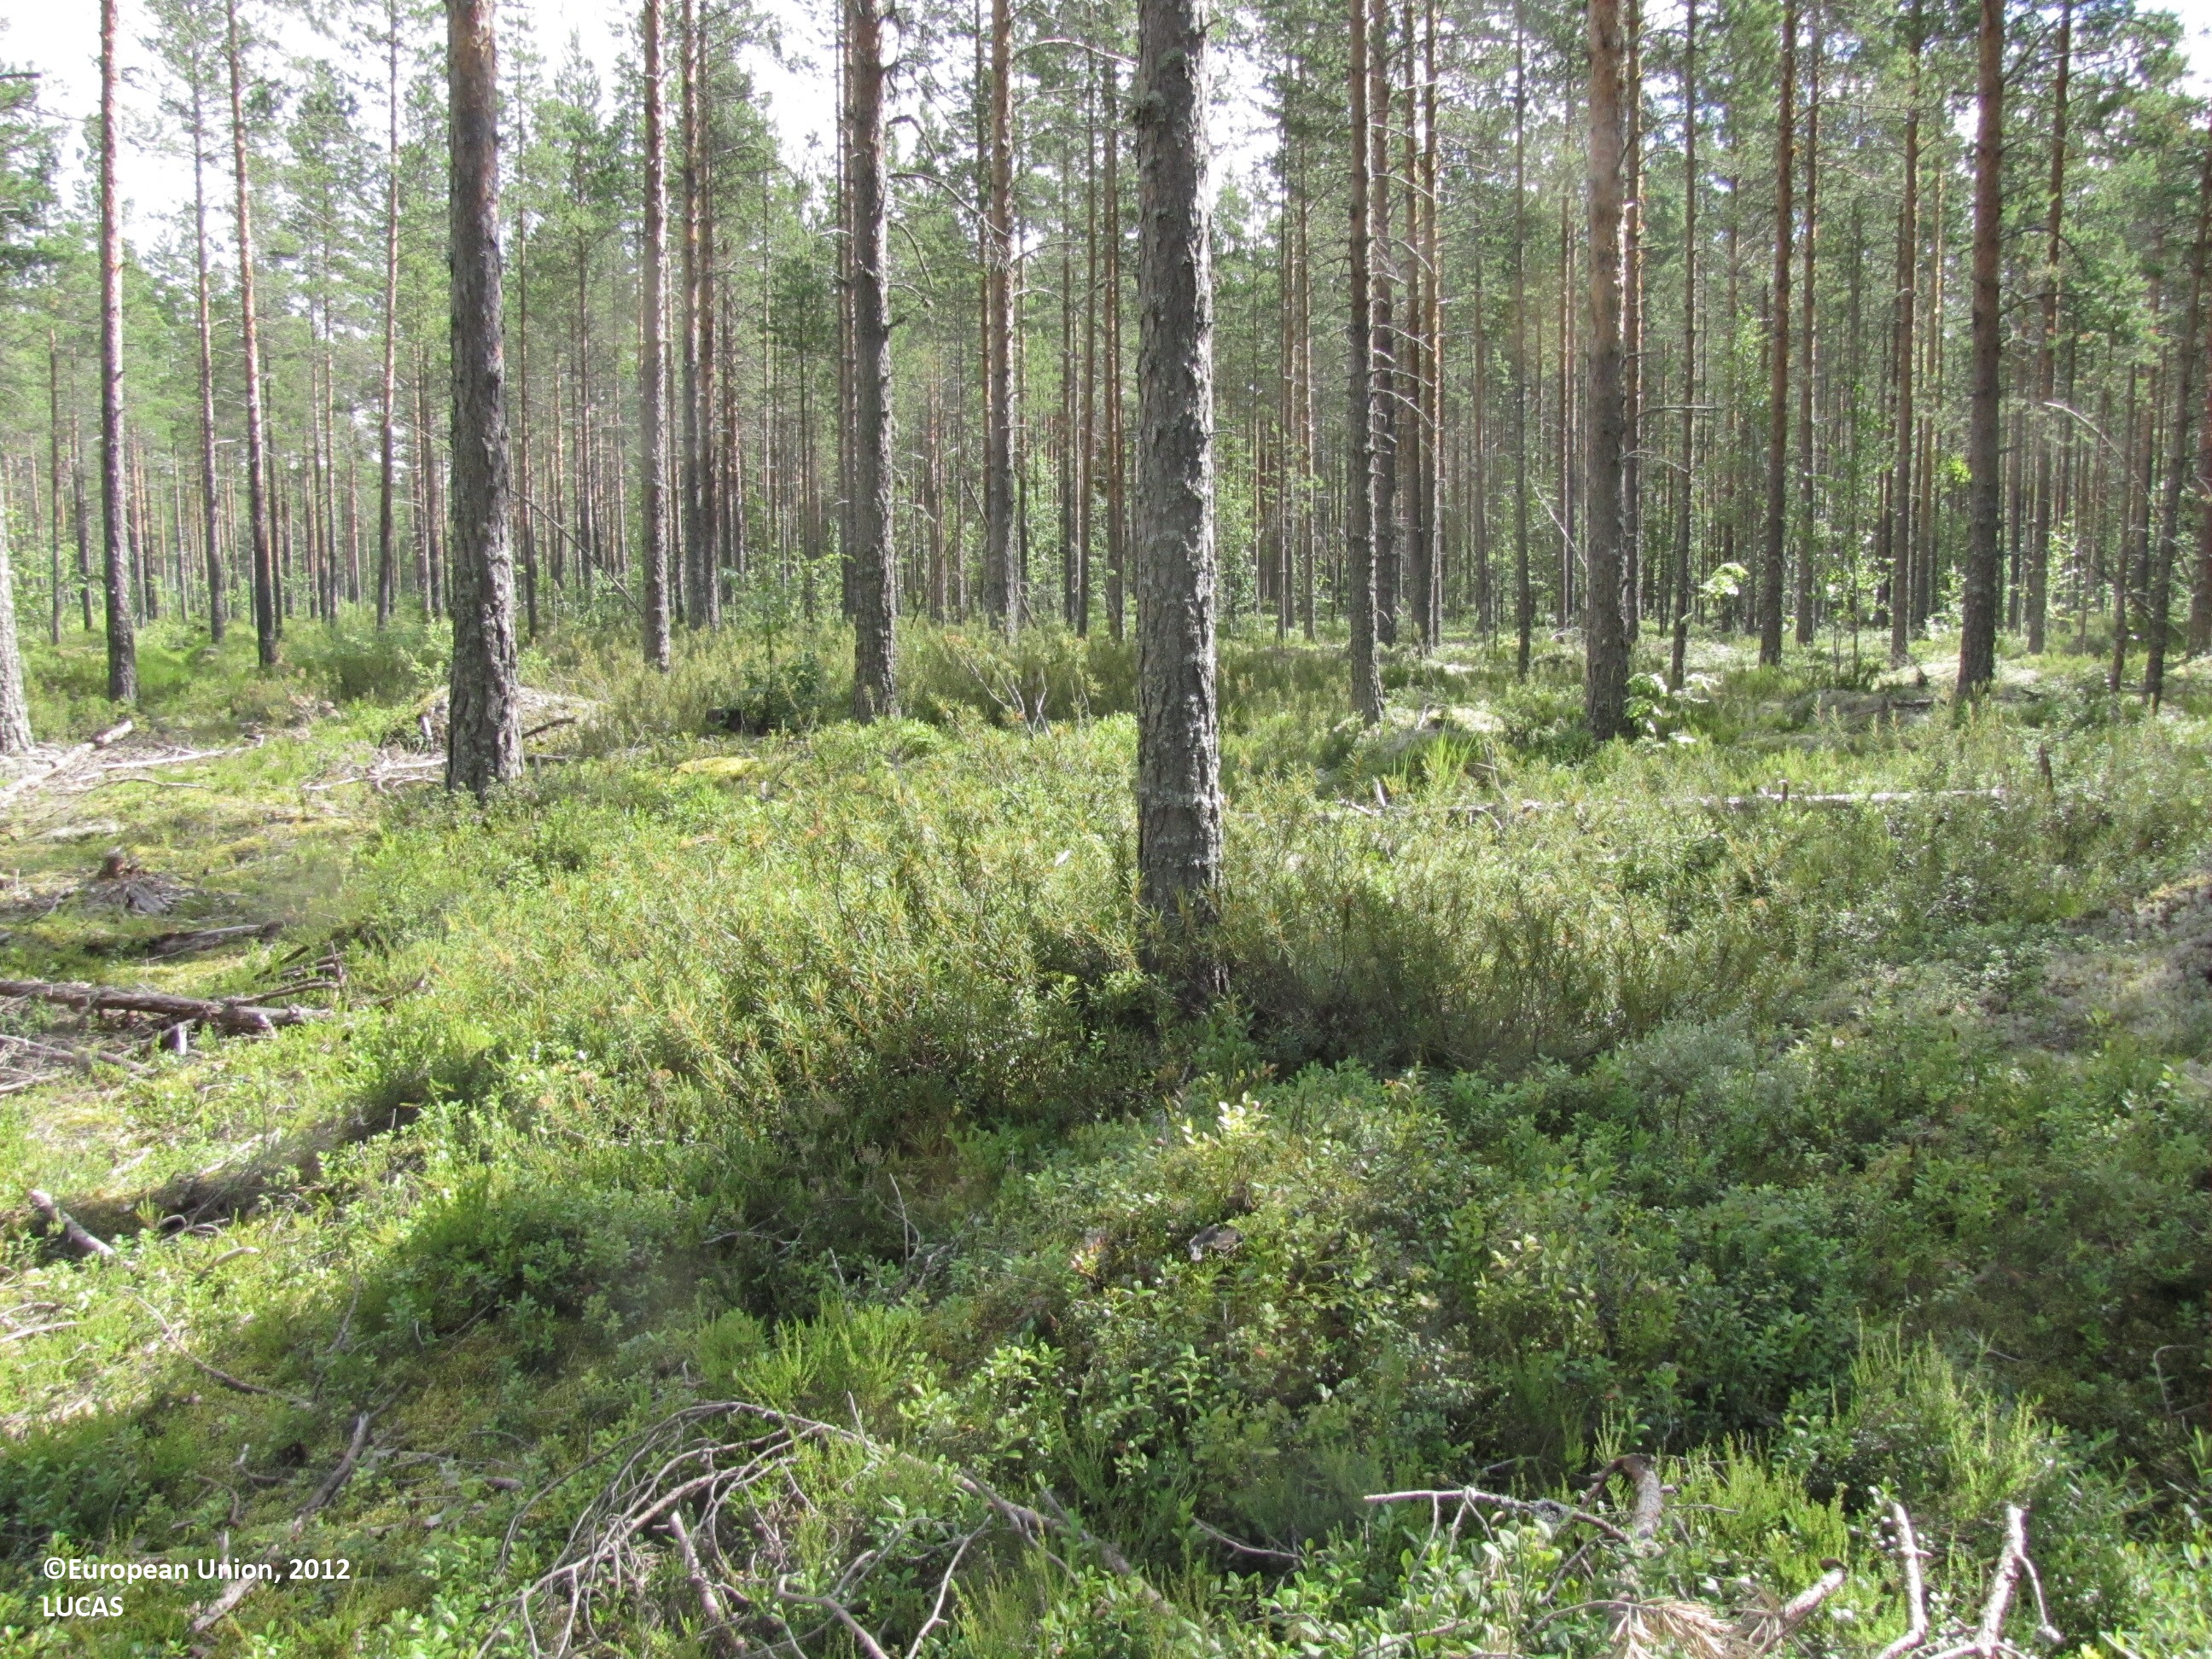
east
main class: Woodland
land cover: Pine dominated coniferous woodland
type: boreal forest
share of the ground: 50 - 75 %
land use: Forestry
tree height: > 5 m
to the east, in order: Pine dominated coniferous woodland; Pine dominated mixed woodland; Ditches and canals; Grass margins; Tracks; Grass margins; Ditches and canals; Other mixed woodland; Pine dominated coniferous woodland
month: July
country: FI
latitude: 62.6692
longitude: 23.2039
